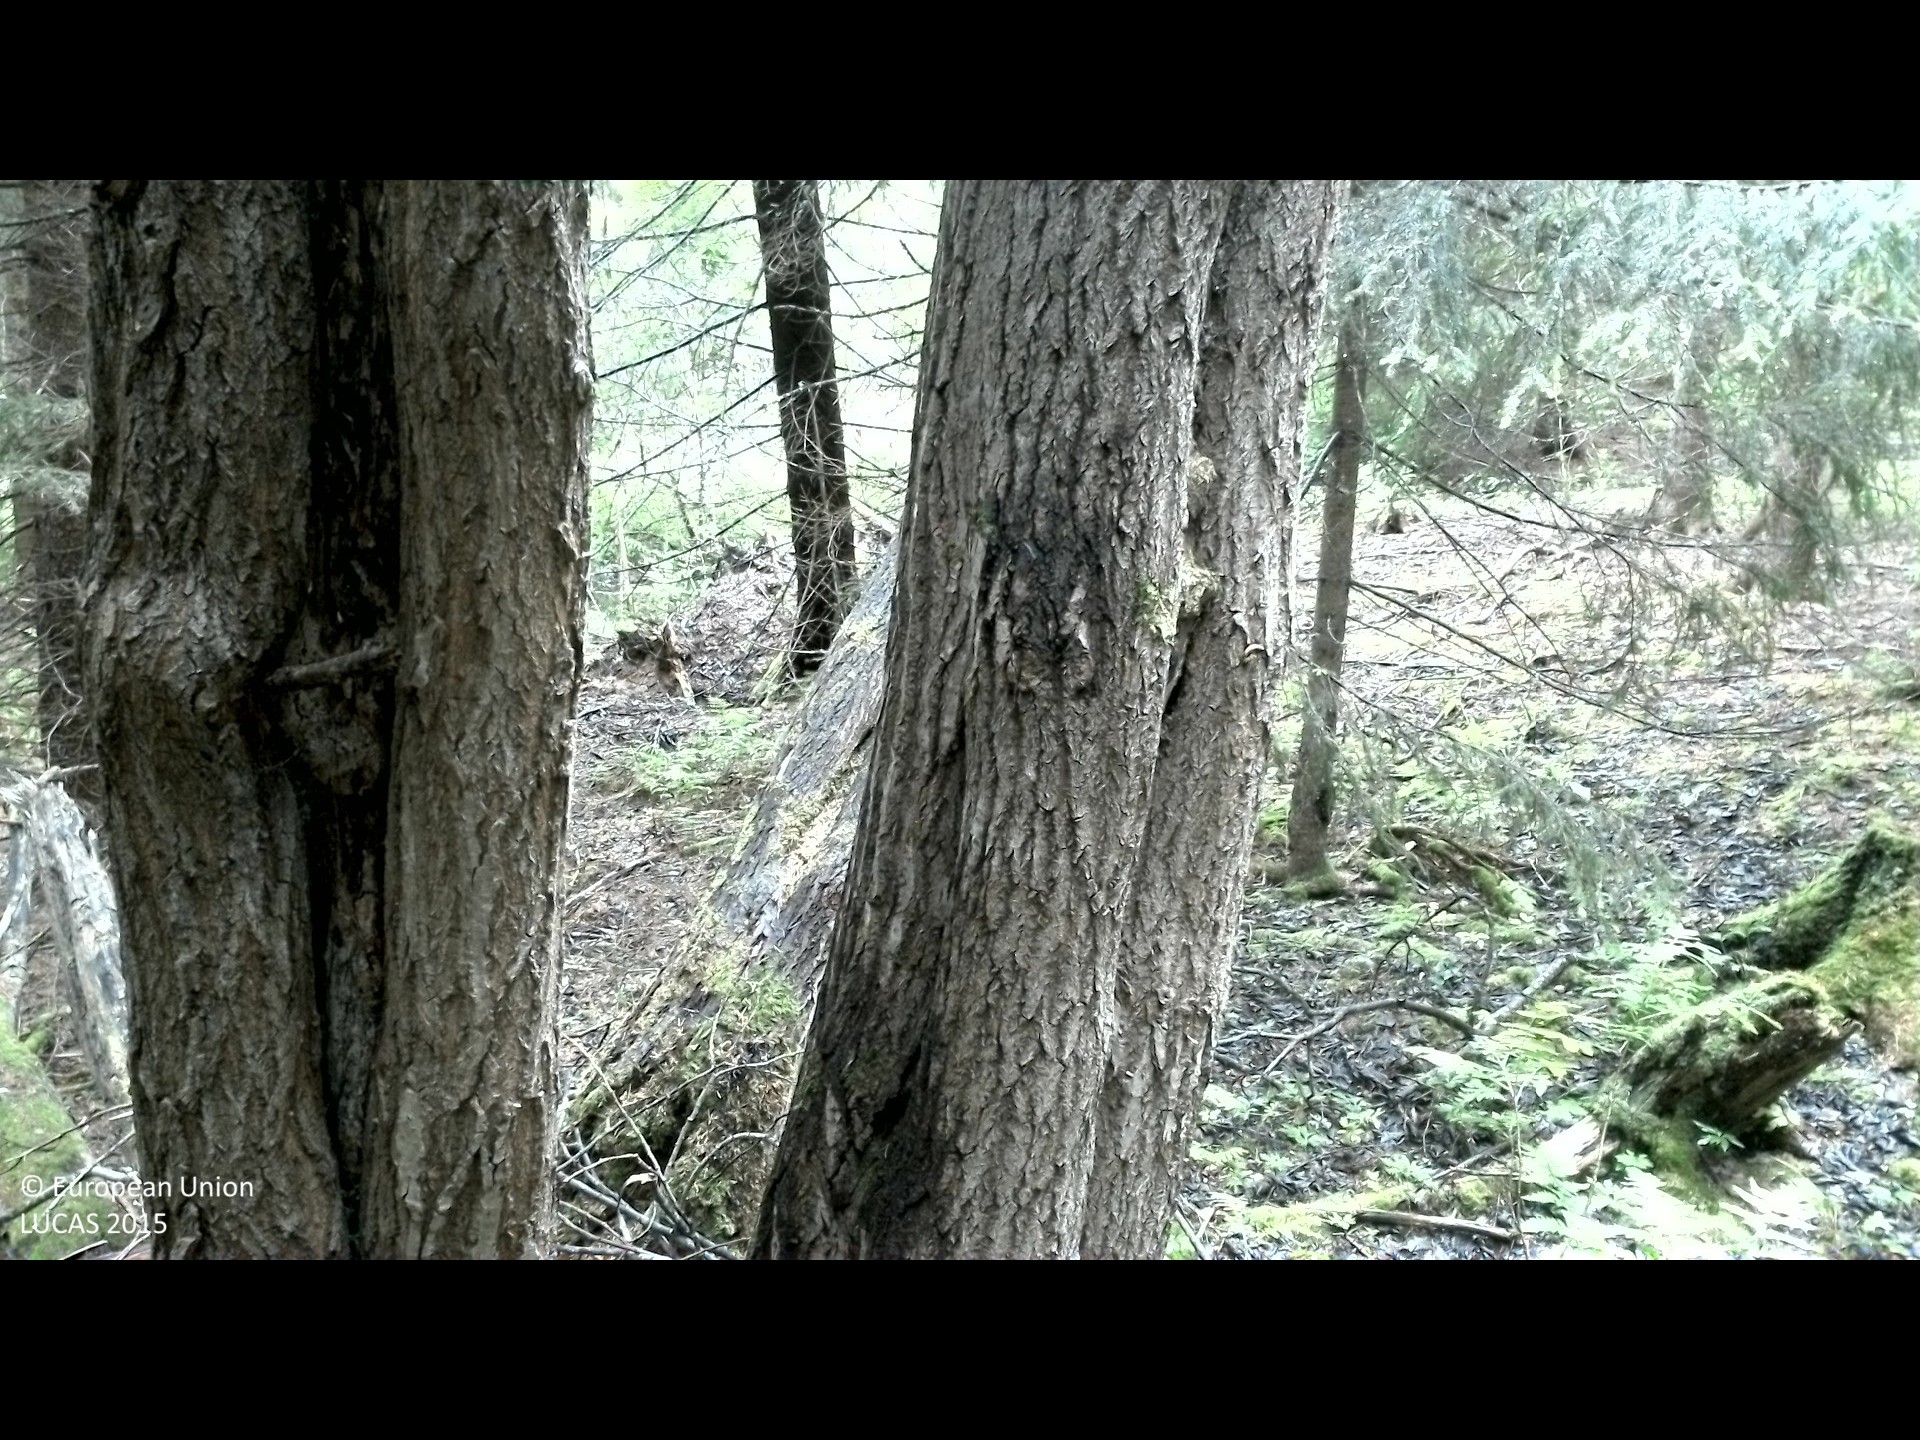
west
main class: Woodland
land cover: Spruce dominated coniferous woodland
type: boreal forest
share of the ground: 50 - 75 %
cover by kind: coniferous forest trees 45 %, herbaceous plants 25 %, lichens and mosses 25 %, broadleaved forest trees 5 %
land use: Forestry
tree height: > 5 m
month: June
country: SE
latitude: 61.9562
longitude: 17.0943
